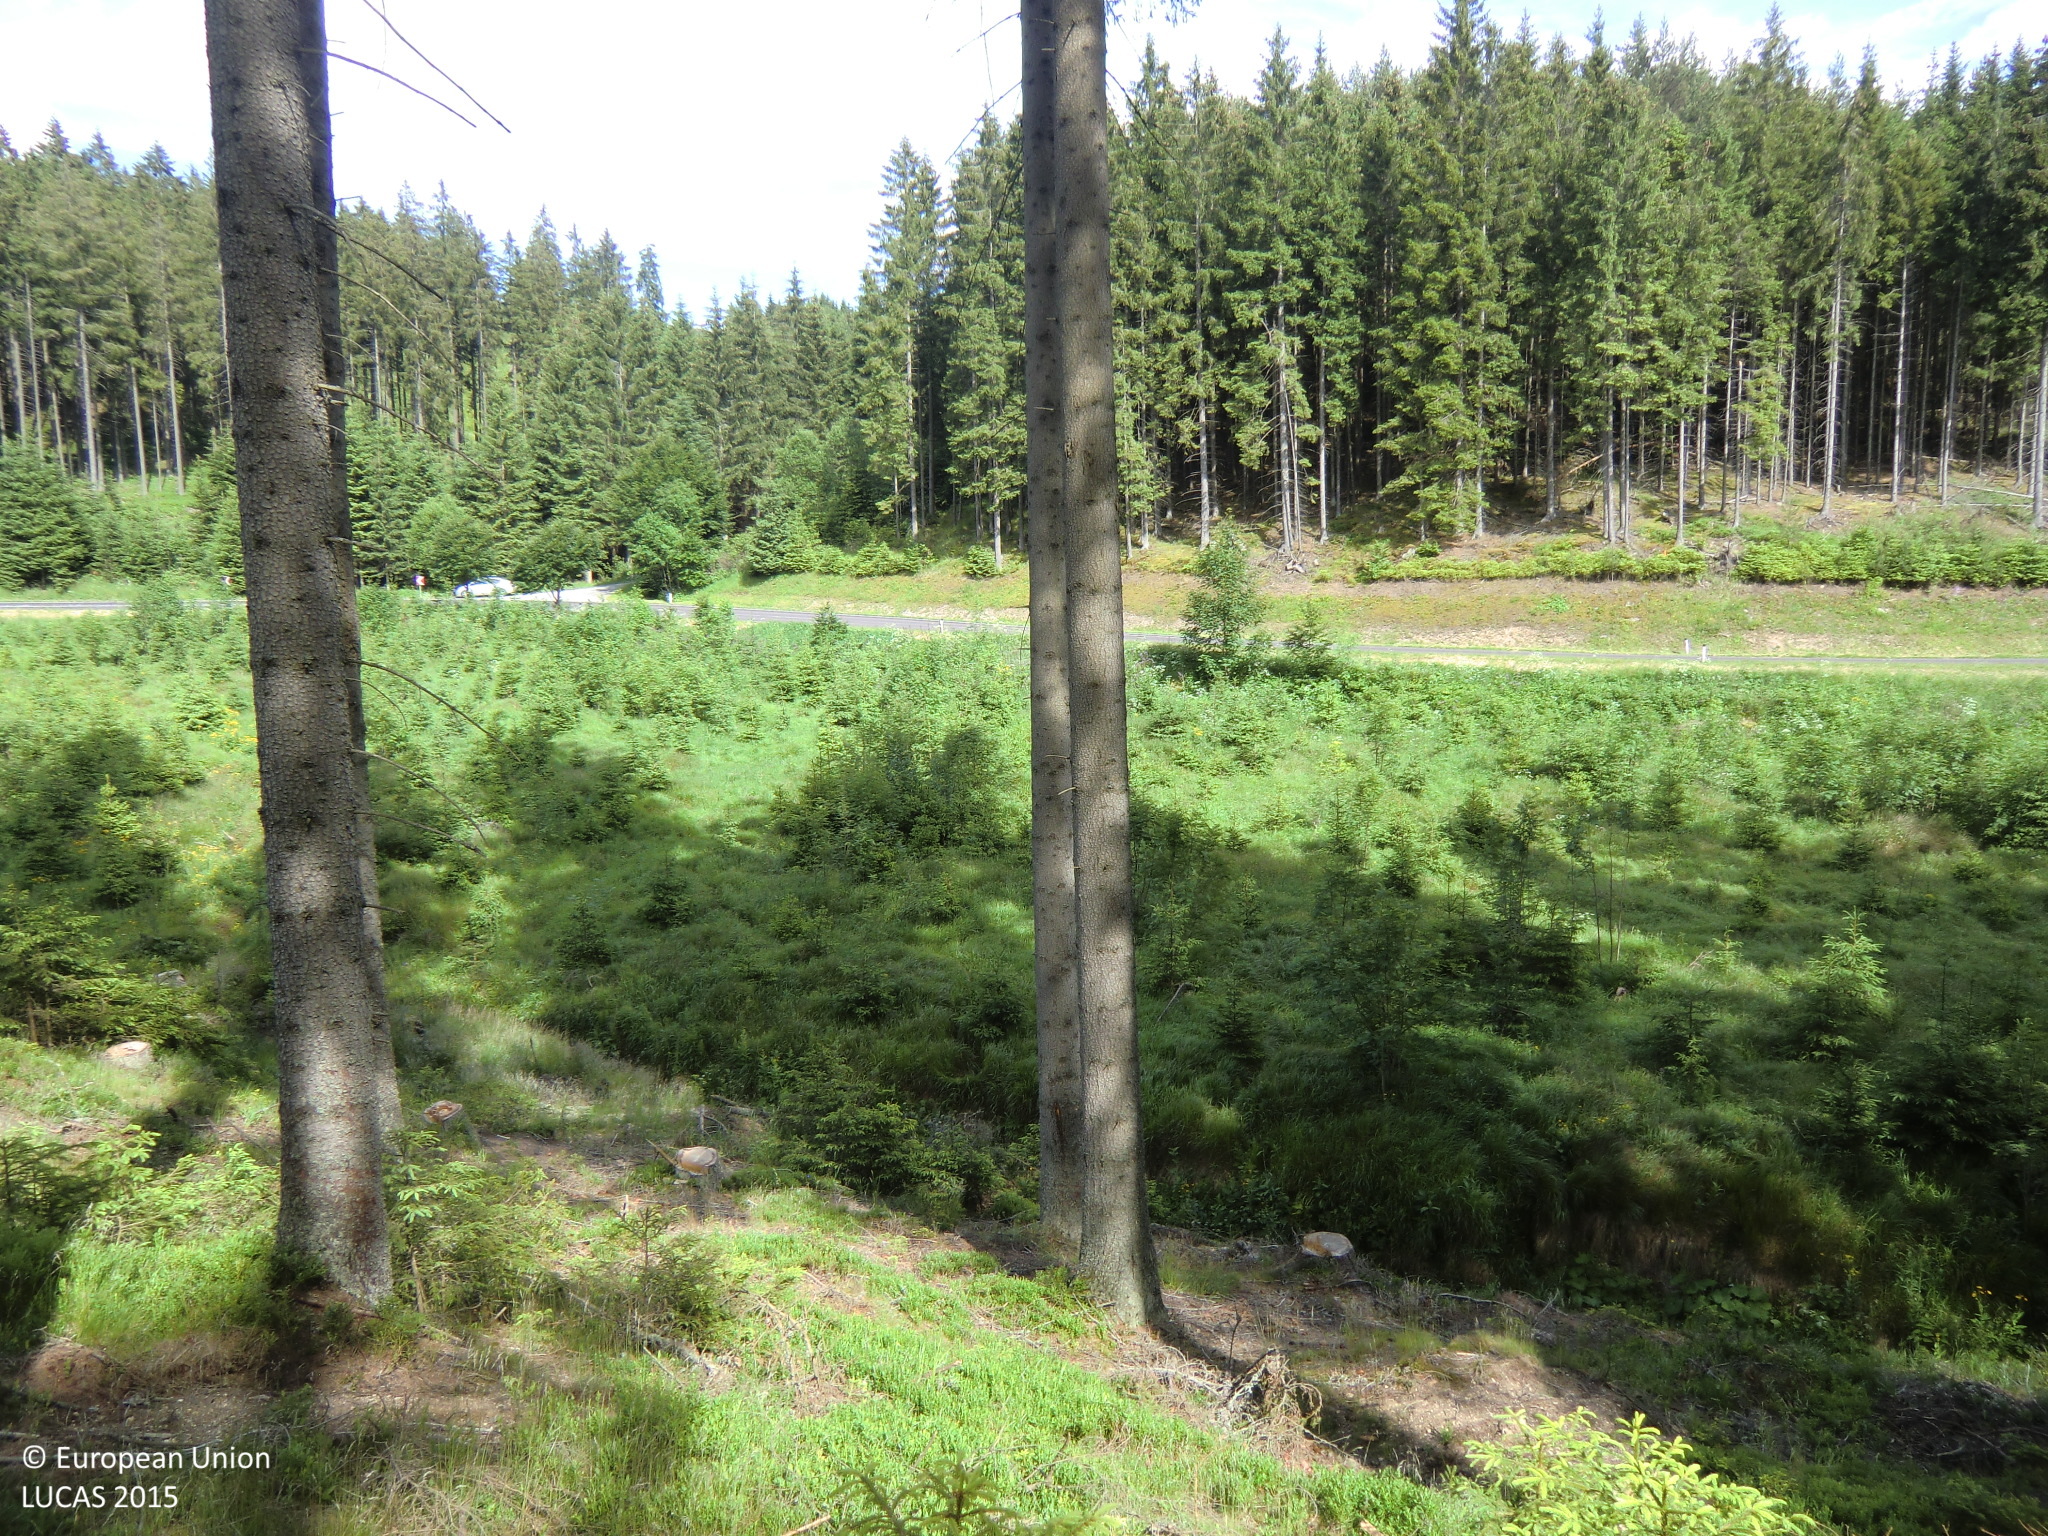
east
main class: Woodland
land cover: Spruce dominated coniferous woodland
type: hemiboreal forest and nemoral coniferous forest and mixed broadleaved-coniferous forest
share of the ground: 50 - 75 %
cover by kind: coniferous forest trees 70 %, shrubs 15 %, herbaceous plants 15 %
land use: Forestry
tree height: > 5 m
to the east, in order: Spruce dominated coniferous woodland; Rivers and streams; Spruce dominated coniferous woodland; Paved roads, cycling and walking lanes; Grass margins; Spruce dominated mixed woodland; Tracks; Rivers and streams; Spruce dominated coniferous woodland; Rivers and streams; Spruce dominated coniferous woodland; Grassland with sparse tree/shrub cover
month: June
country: AT
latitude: 48.5500
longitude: 14.8376
